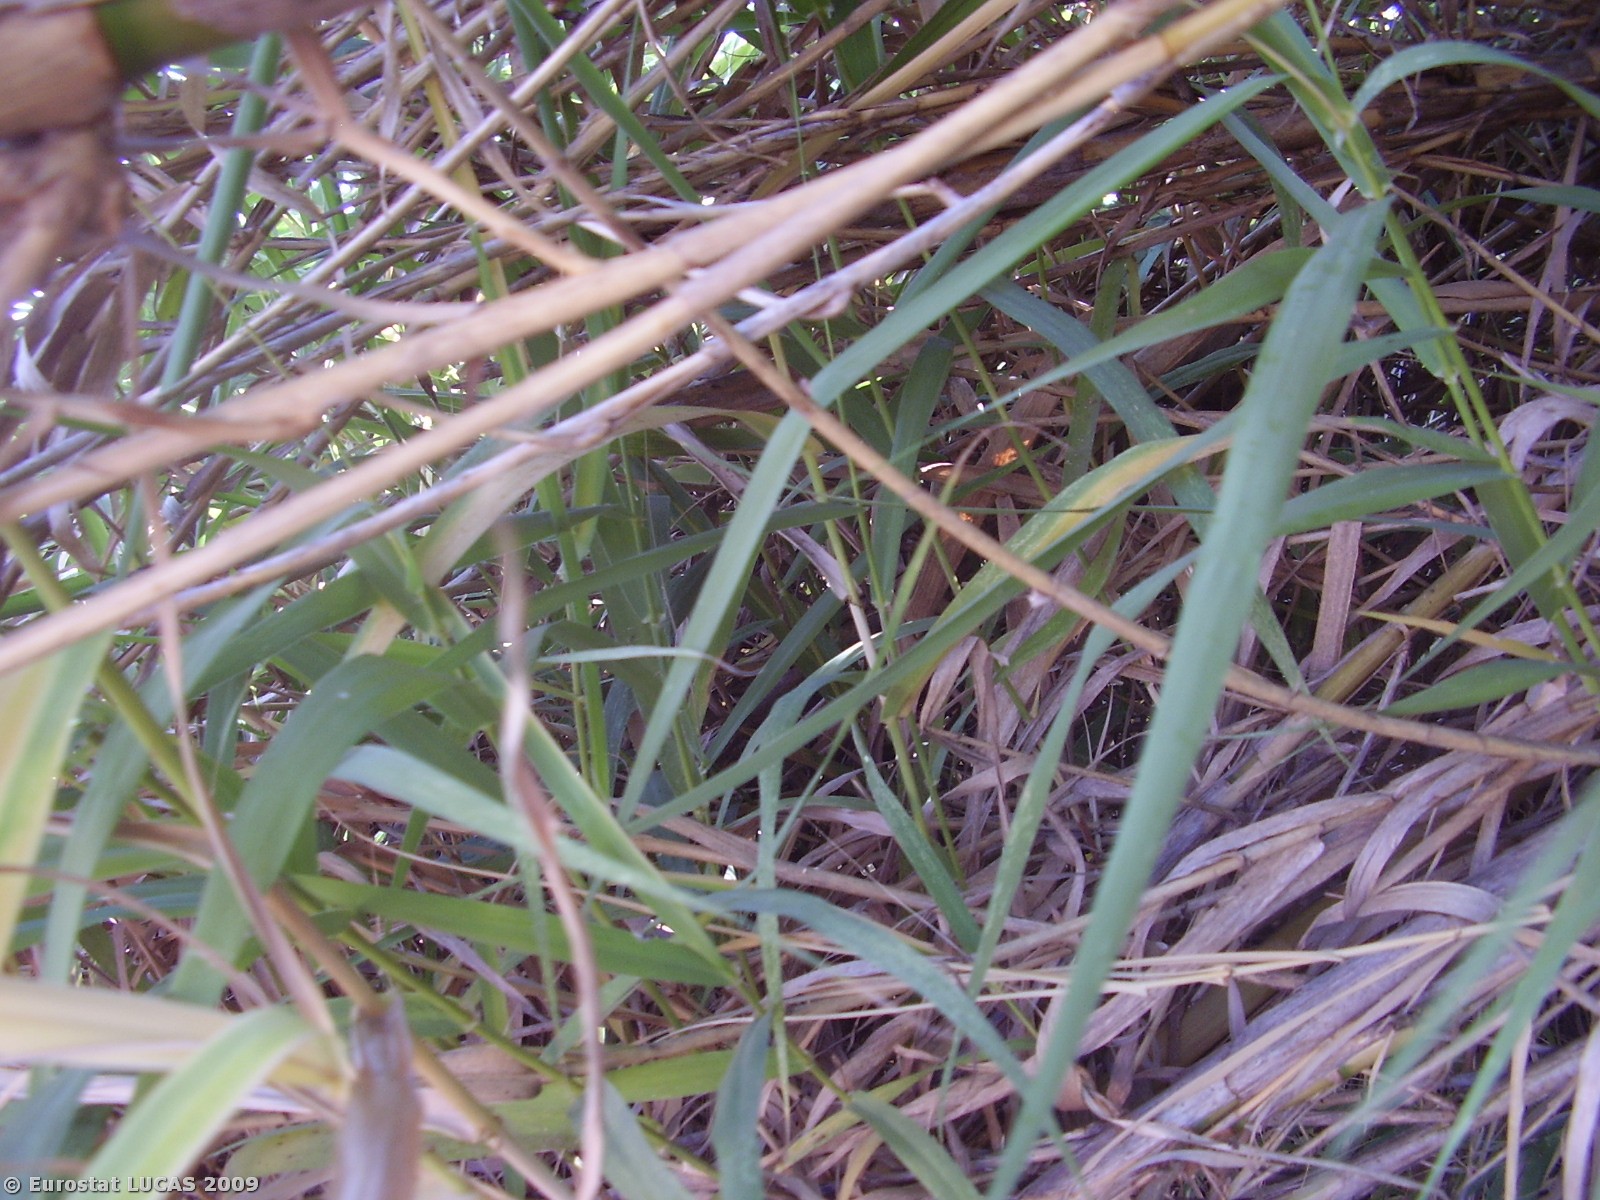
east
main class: Wetlands
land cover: Inland marshes
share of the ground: > 75 %
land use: Unused
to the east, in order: Inland marshes; Shrubland without tree cover; Rivers and streams; Shrubland without tree cover; Spontaneously vegetated surfaces; Olive groves; Tracks; Spontaneously vegetated surfaces; Inland running water
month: July
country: PT
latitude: 38.0178
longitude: -7.7840
